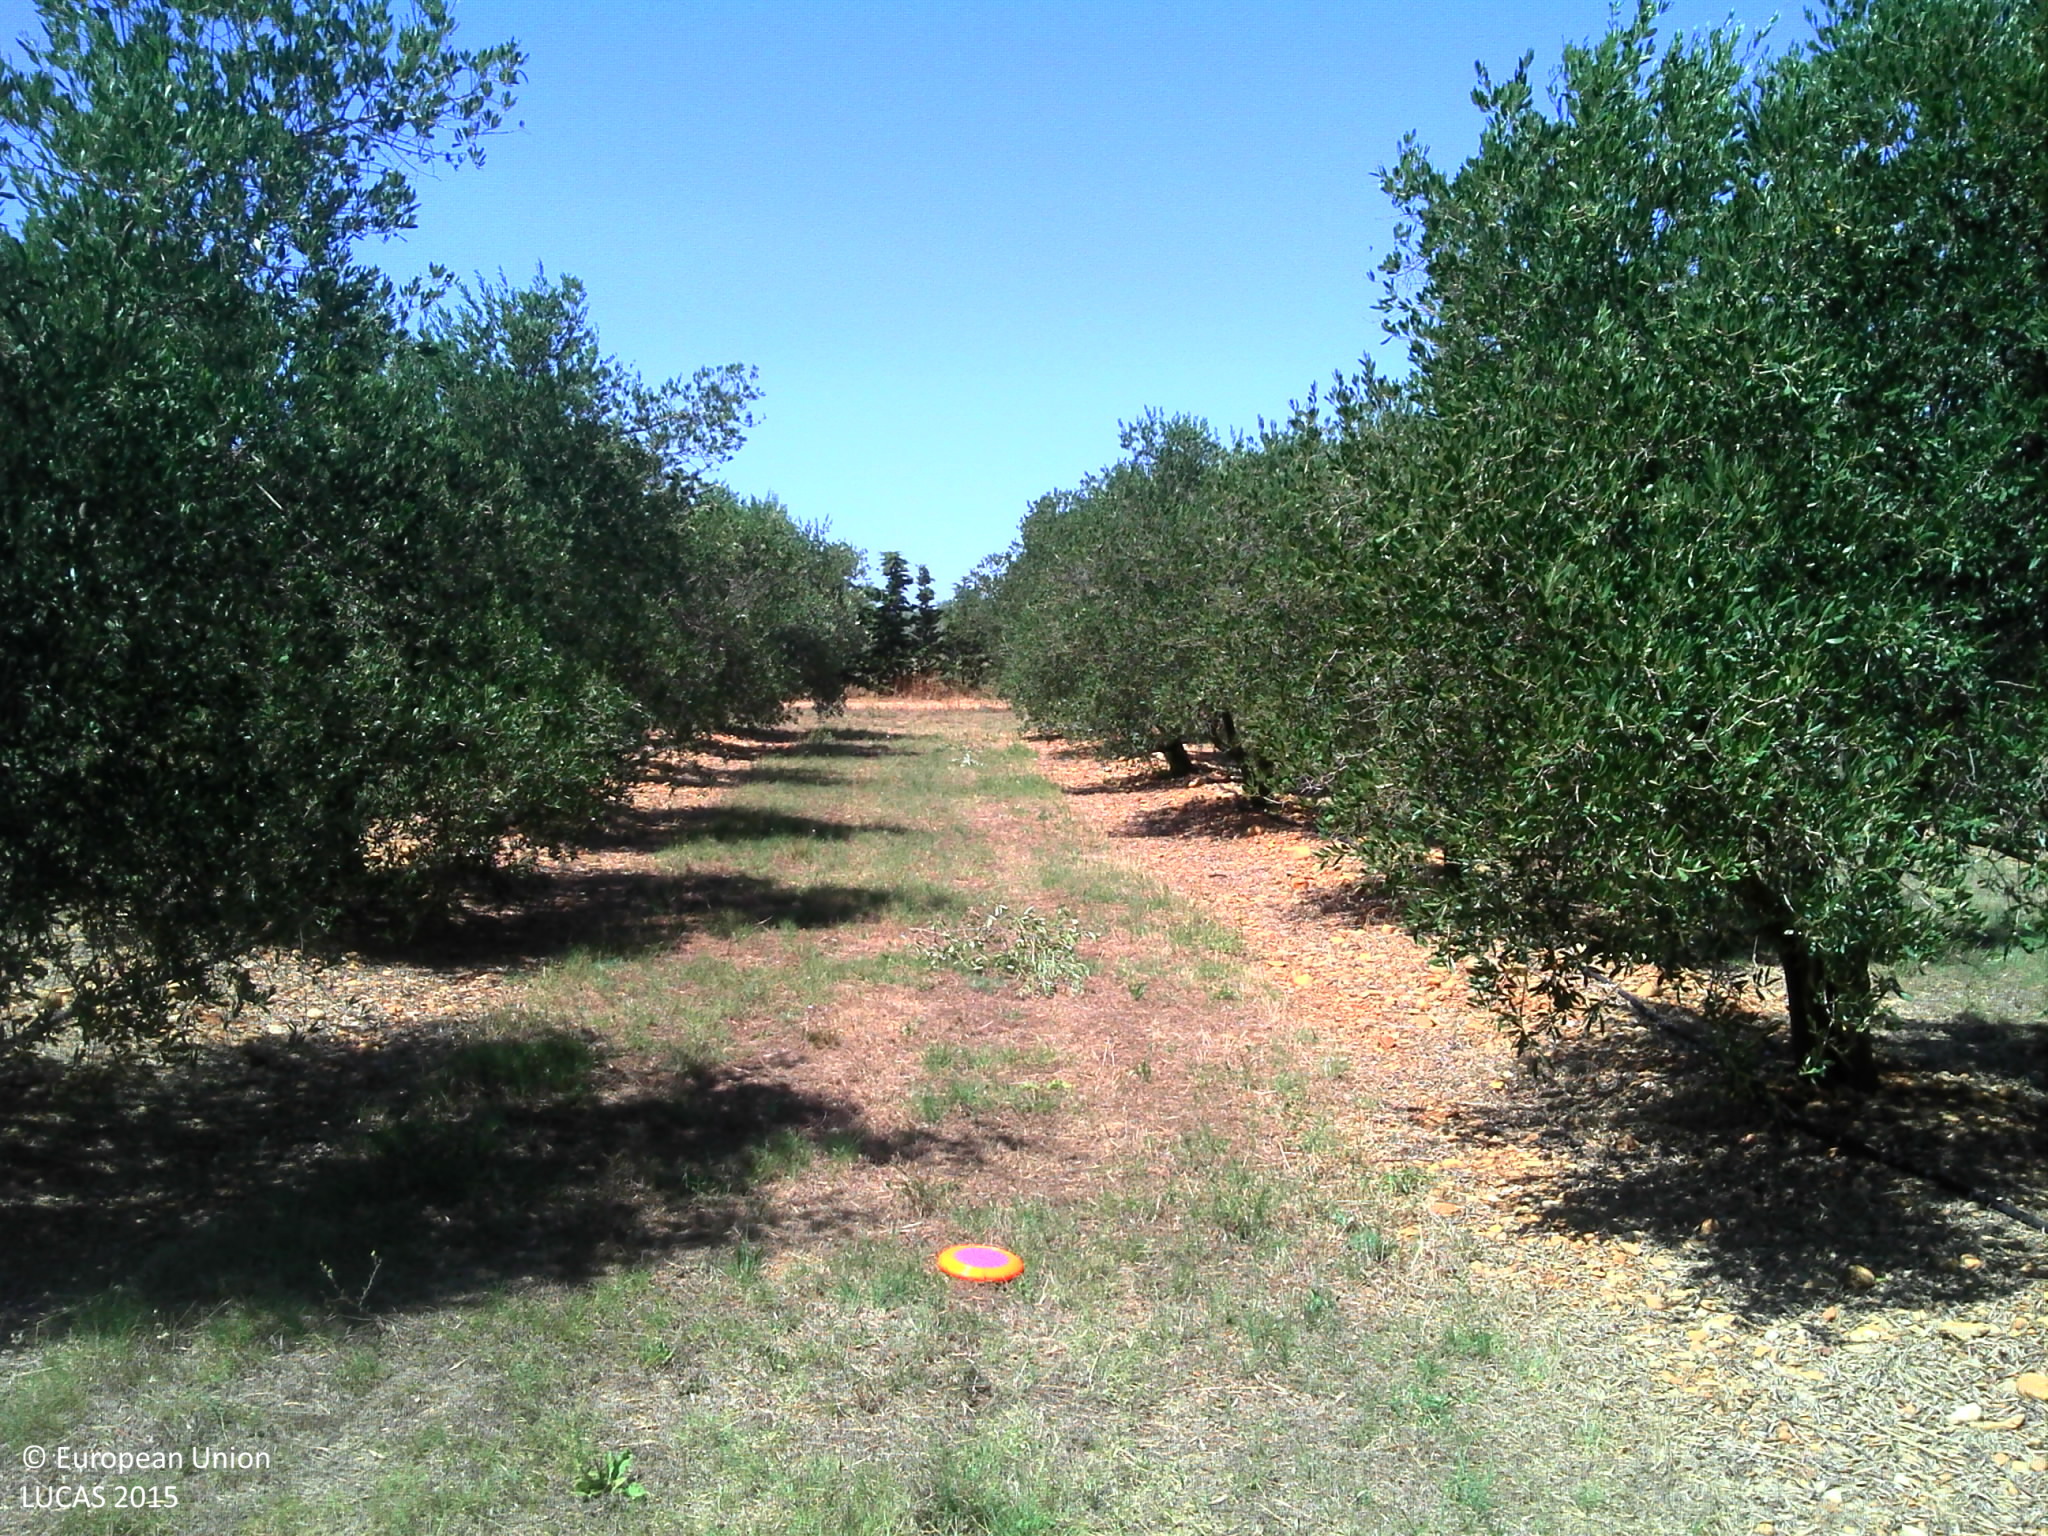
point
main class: Cropland
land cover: Olive groves
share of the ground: 25 - 50 %
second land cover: Grassland without tree/shrub cover
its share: > 75 %
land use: Agriculture (excluding fallow land and kitchen gardens)
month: July
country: FR
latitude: 43.6761
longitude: 4.7627
